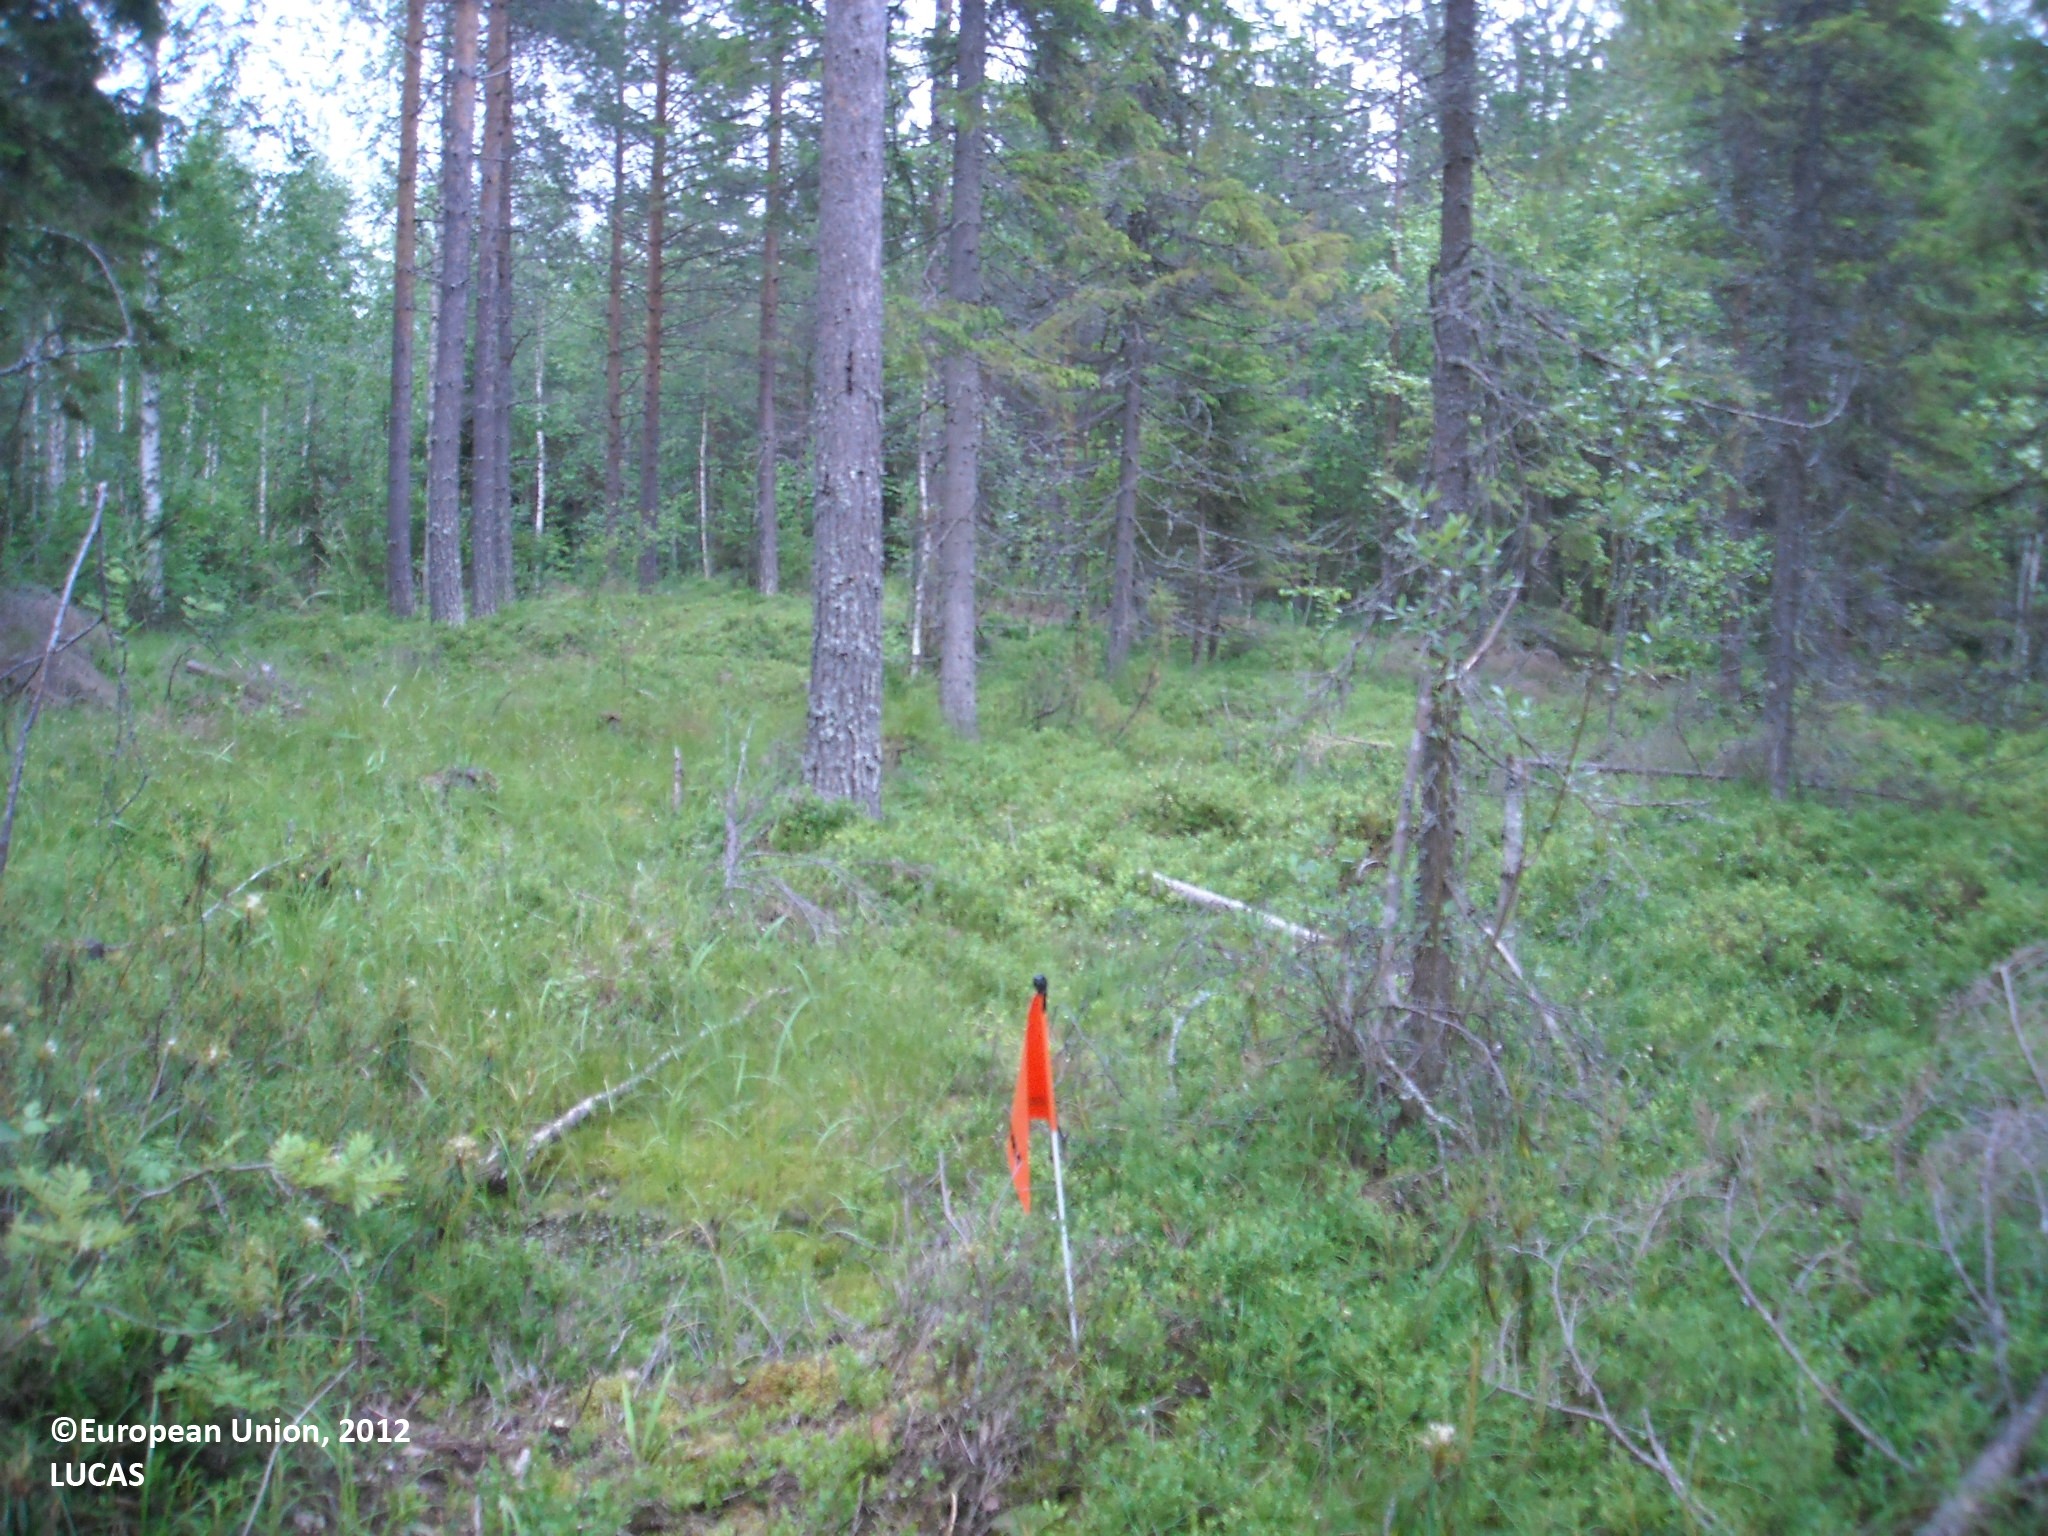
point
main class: Woodland
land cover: Other coniferous woodland
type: mire and swamp forests
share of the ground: > 75 %
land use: Forestry
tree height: > 5 m
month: July
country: FI
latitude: 64.4118
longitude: 27.5567
